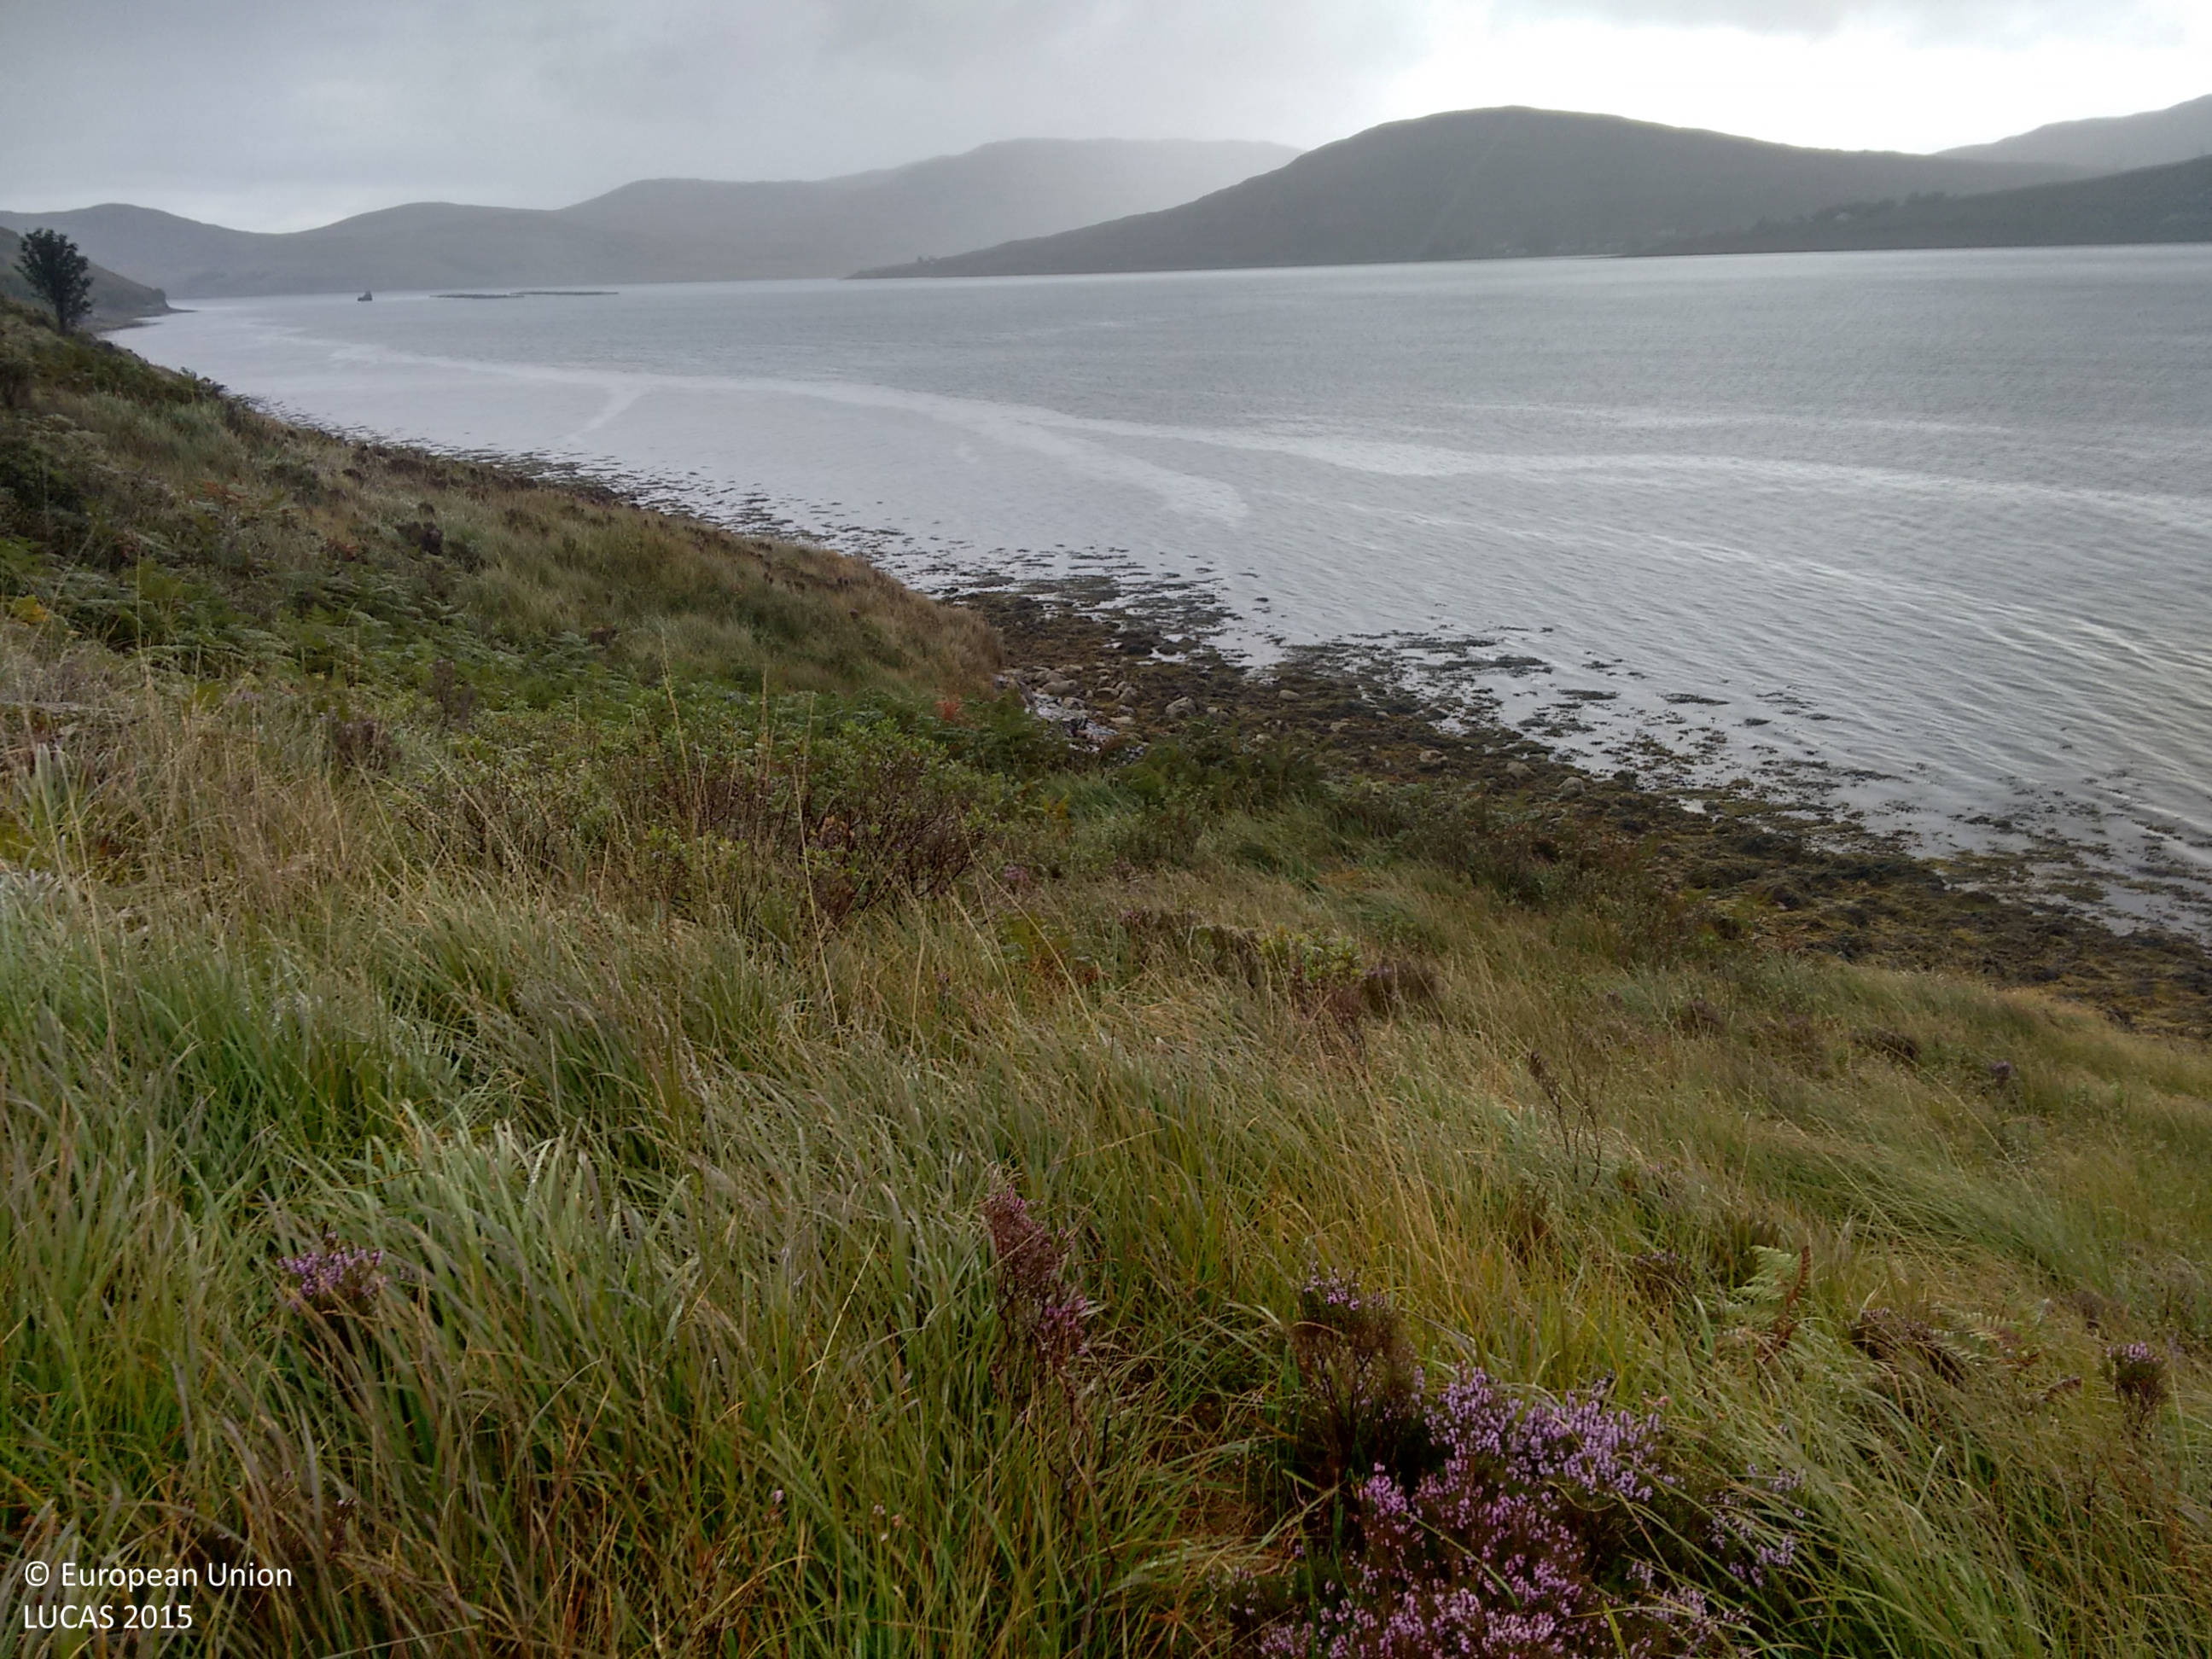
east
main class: Shrubland
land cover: Shrubland without tree cover
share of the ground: 50 - 75 %
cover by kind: shrubs 60 %, herbaceous plants 40 %
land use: Semi-natural and natural areas not in use
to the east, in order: Shrubland without tree cover; Rocks and stones; Transitional water bodies
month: September
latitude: 57.2792
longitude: -6.0718
